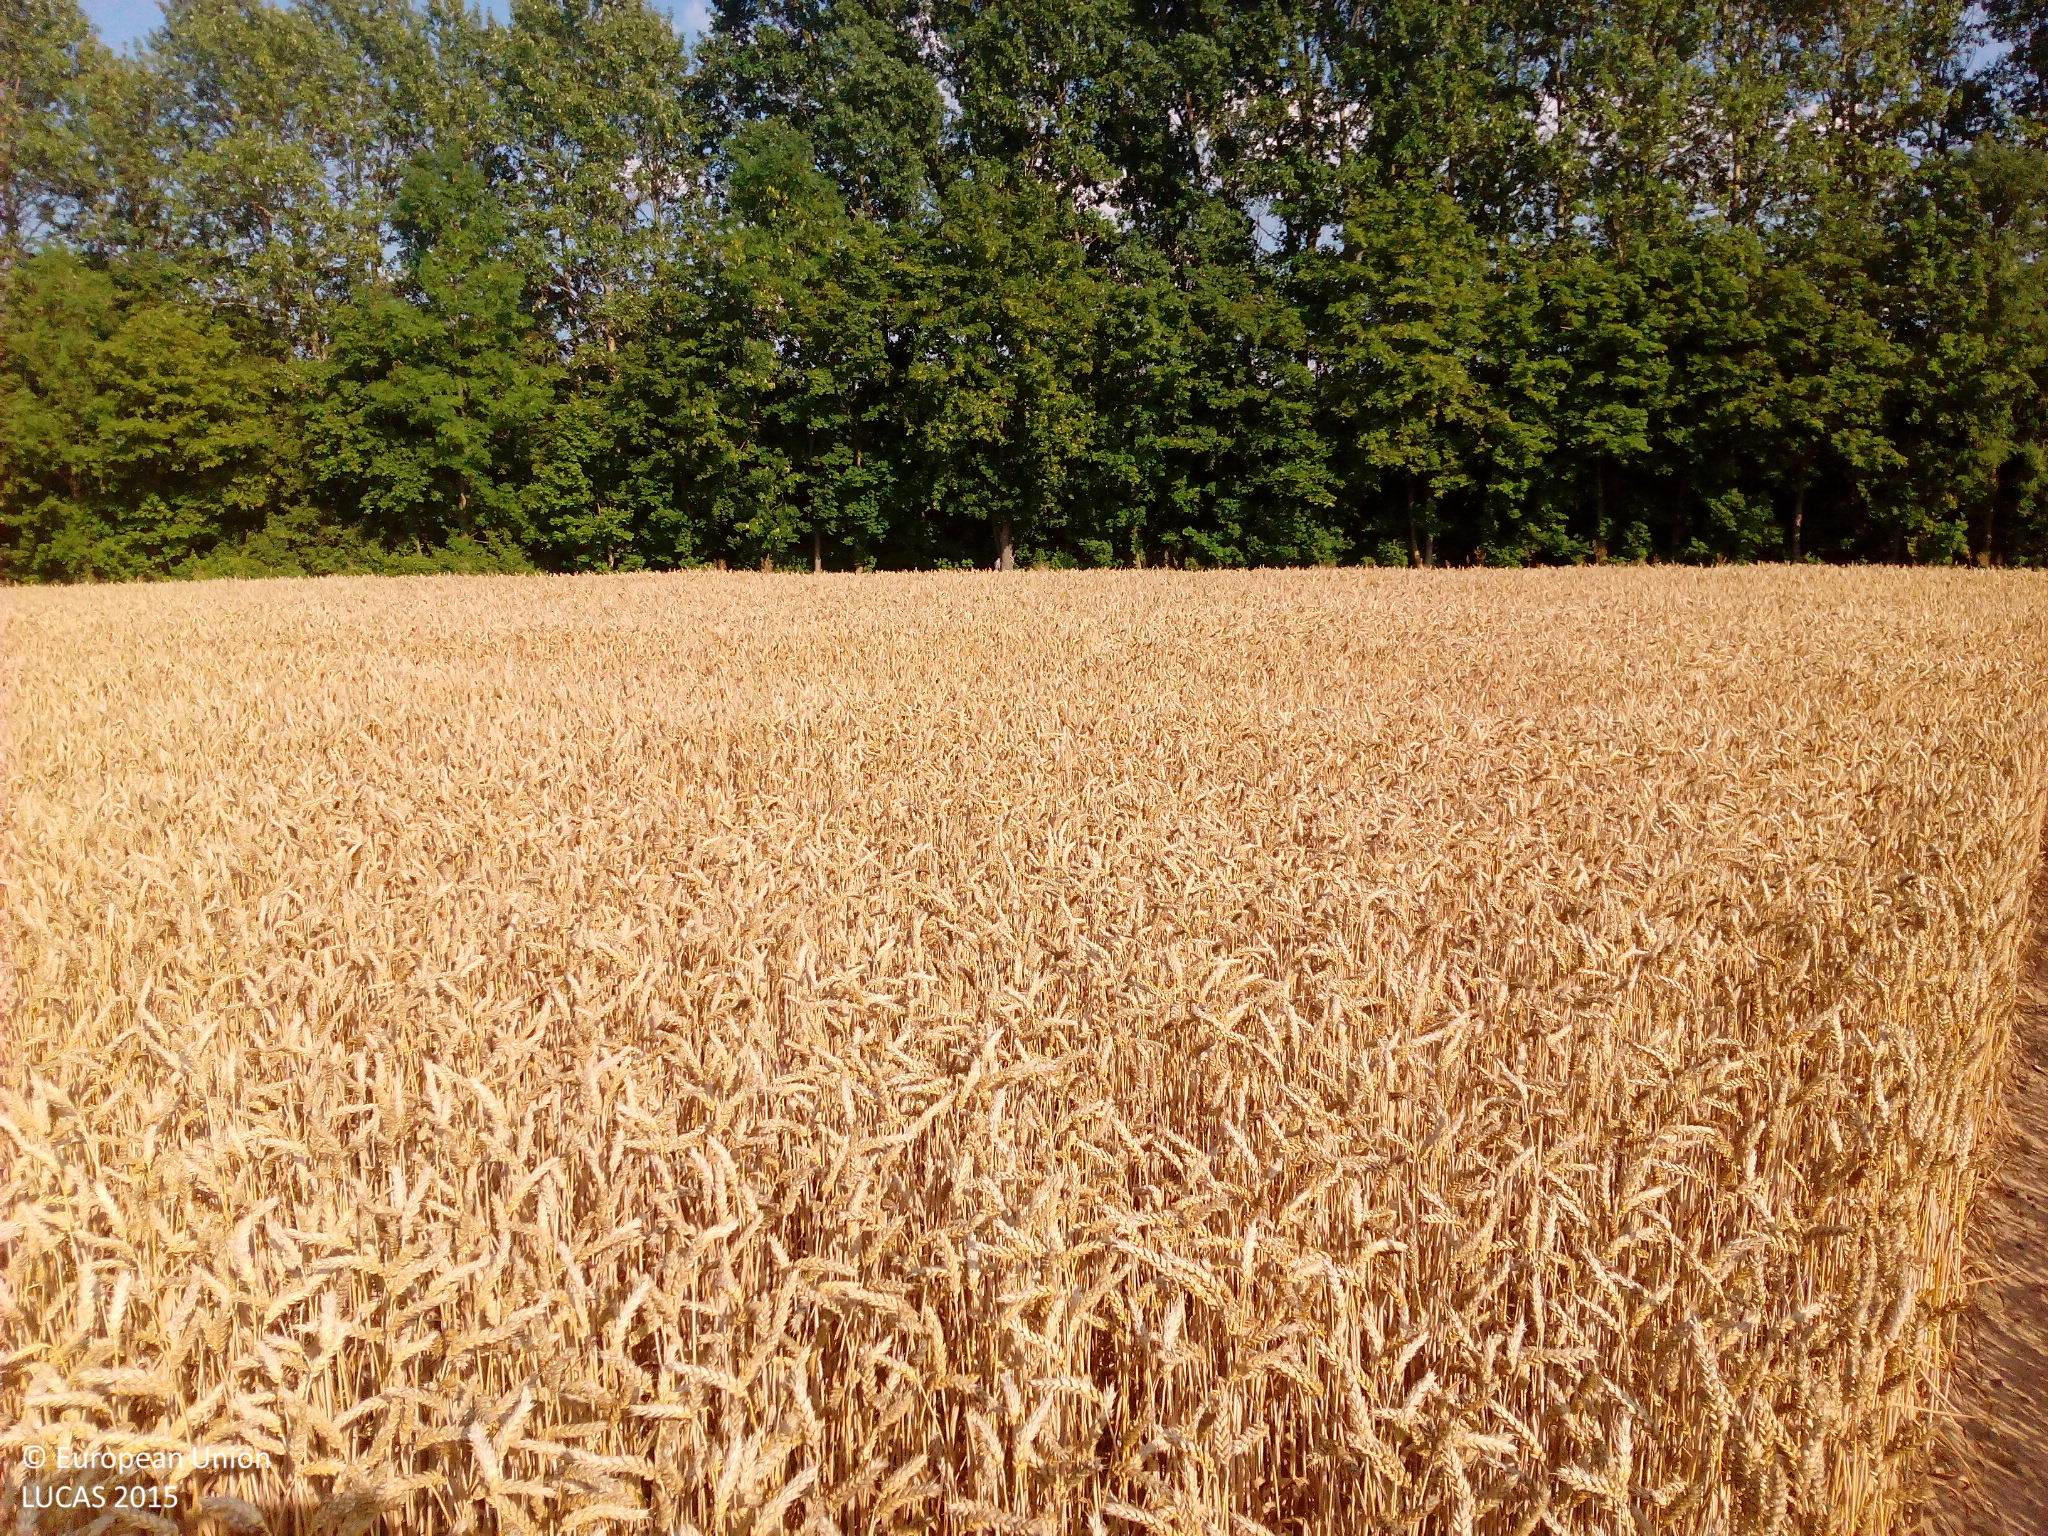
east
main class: Cropland
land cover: Common wheat
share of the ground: > 75 %
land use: Agriculture (excluding fallow land and kitchen gardens)
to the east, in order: Common wheat; Temporary grasslands; Tracks; Grassland without tree/shrub cover; Broadleaved woodland; Inland fresh water bodies
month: August
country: DE
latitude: 53.6180
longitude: 13.6129
